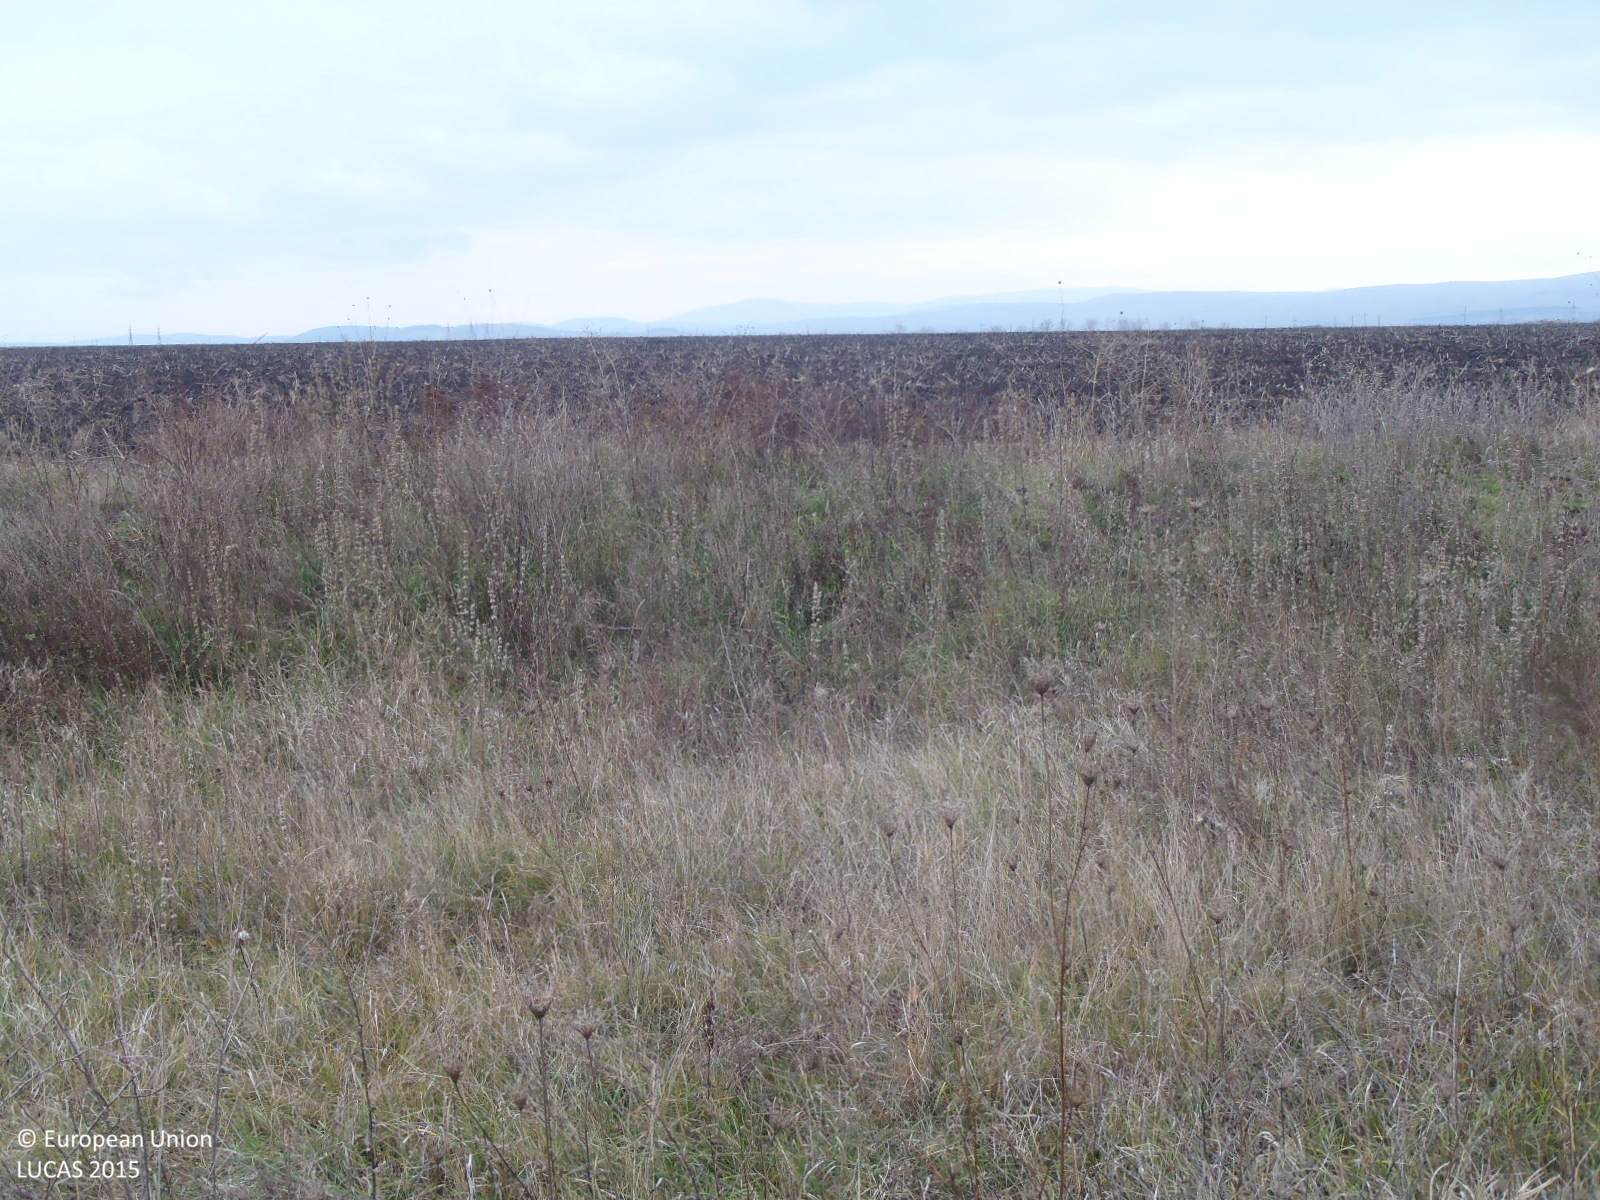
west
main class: Grassland
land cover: Grassland with sparse tree/shrub cover
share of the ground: > 75 %
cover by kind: herbaceous plants 85 %, shrubs 10 %, broadleaved forest trees 5 %
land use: Community services
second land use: Telecommunication
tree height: < 5 m
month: December
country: BG
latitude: 42.8118
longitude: 23.1800
